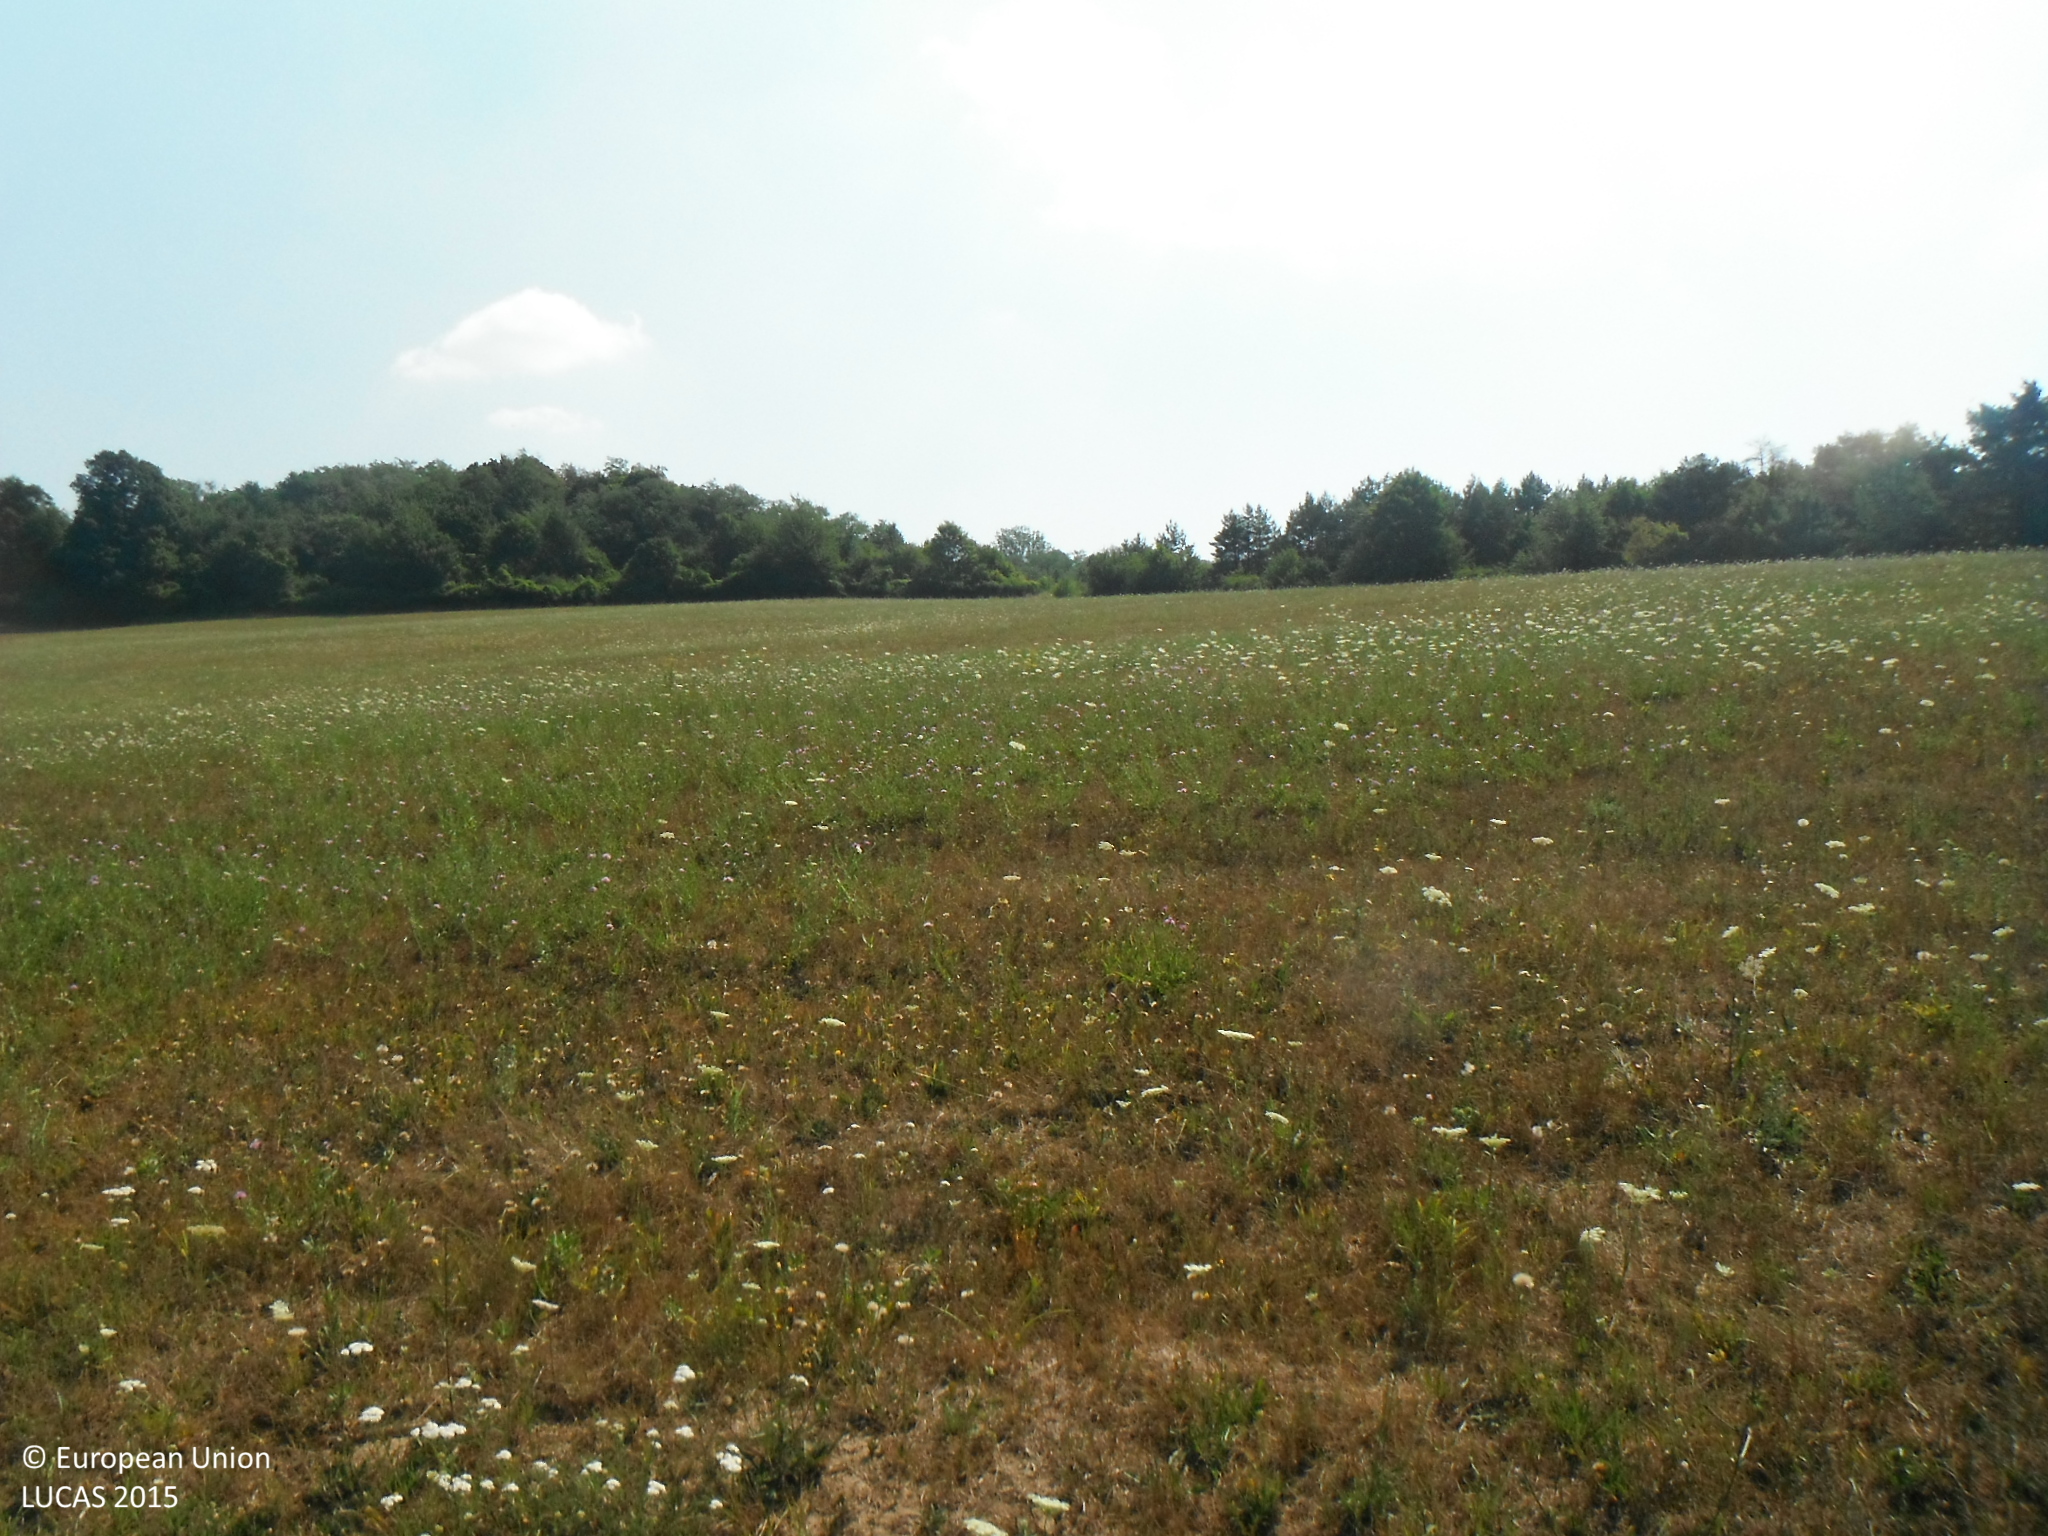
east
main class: Grassland
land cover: Grassland without tree/shrub cover
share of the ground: > 75 %
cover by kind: herbaceous plants 100 %
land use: Agriculture (excluding fallow land and kitchen gardens)
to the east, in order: Grassland without tree/shrub cover; Tracks; Grassland without tree/shrub cover; Broadleaved woodland
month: July
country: SK
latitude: 48.6748
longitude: 17.4665
